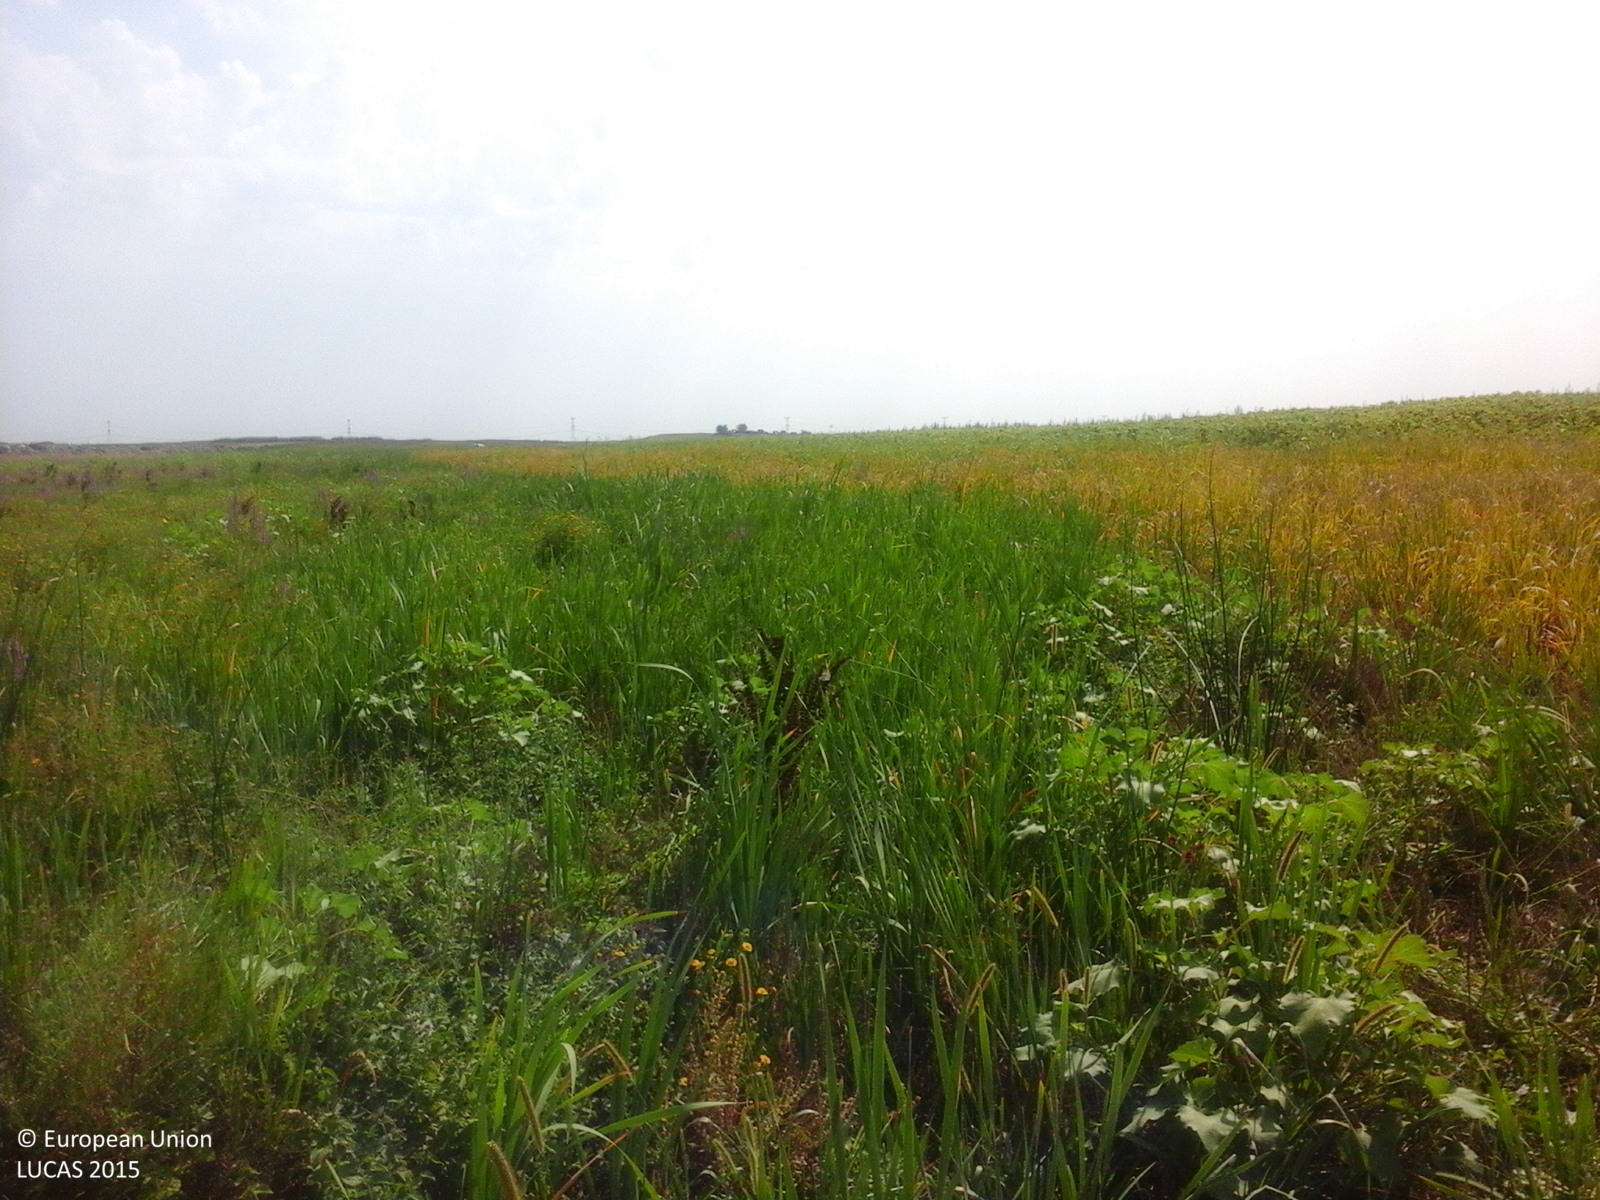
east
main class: Grassland
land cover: Spontaneously vegetated surfaces
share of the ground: > 75 %
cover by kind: herbaceous plants 100 %
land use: Agriculture (excluding fallow land and kitchen gardens)
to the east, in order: Spontaneously vegetated surfaces; Inland marshes; Spontaneously vegetated surfaces; Sunflower
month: August
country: RO
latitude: 43.8495
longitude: 23.6212
